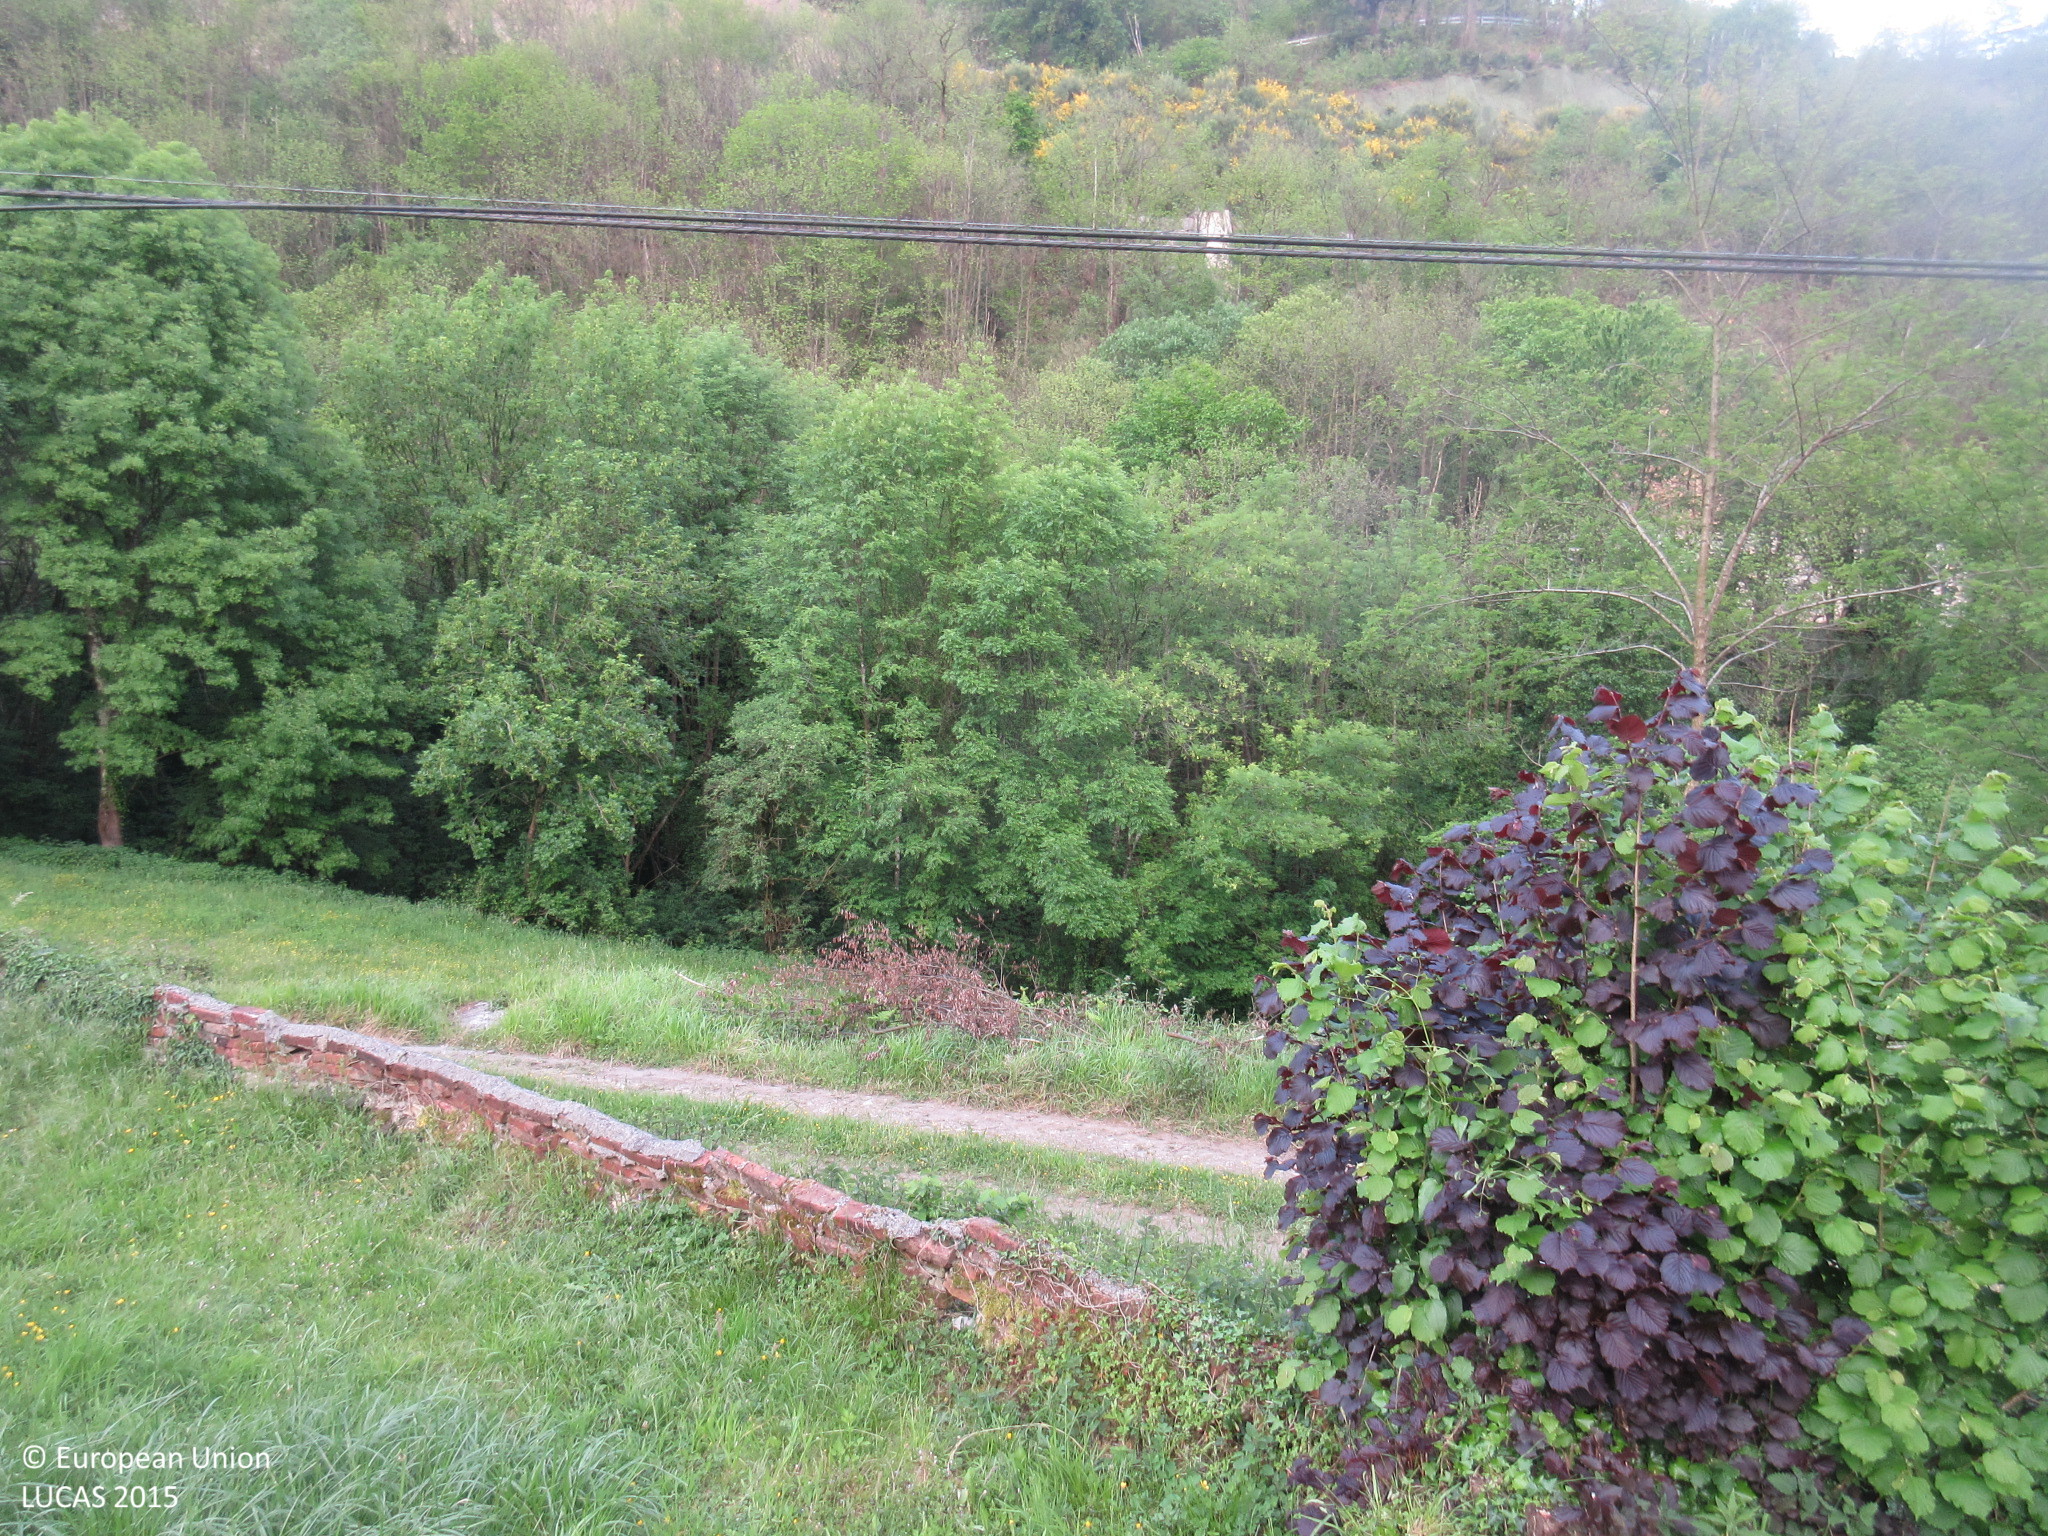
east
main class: Grassland
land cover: Grassland without tree/shrub cover
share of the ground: > 75 %
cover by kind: herbaceous plants 100 %
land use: Agriculture (excluding fallow land and kitchen gardens)
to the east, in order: Grassland without tree/shrub cover; Single bushes/trees; Dry stone walls; Tracks; Electric lines; Shruby margins; Paved roads, cycling and walking lanes; Grassland without tree/shrub cover; Groves; Rivers and streams; Broadleaved woodland; Paved roads, cycling and walking lanes; Broadleaved woodland; Grass margins; Paved roads, cycling and walking lanes; Grass margins; Broadleaved woodland; Paved roads, cycling and walking lanes; Grass margins; Broadleaved woodland
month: May
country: ES
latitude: 43.3083
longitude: -5.6033
